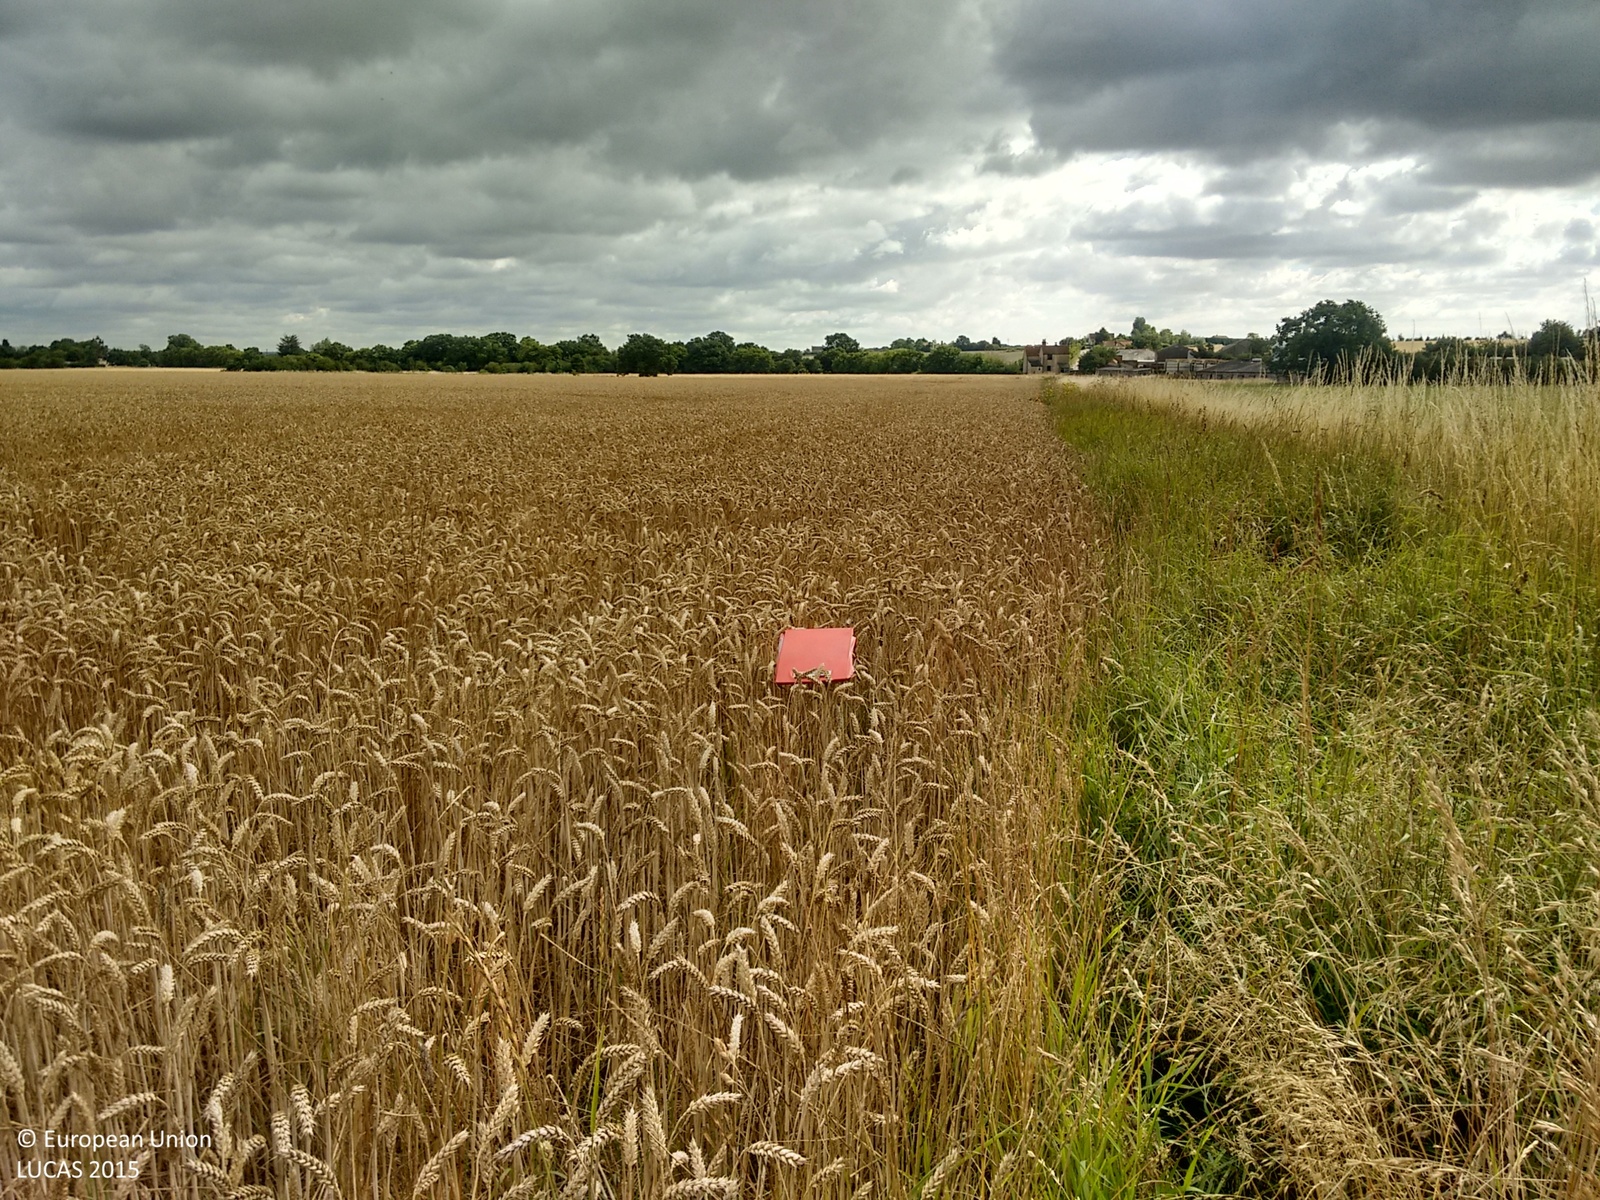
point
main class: Cropland
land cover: Common wheat
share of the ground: > 75 %
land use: Agriculture (excluding fallow land and kitchen gardens)
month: July
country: GB
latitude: 51.6838
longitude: 0.6735
